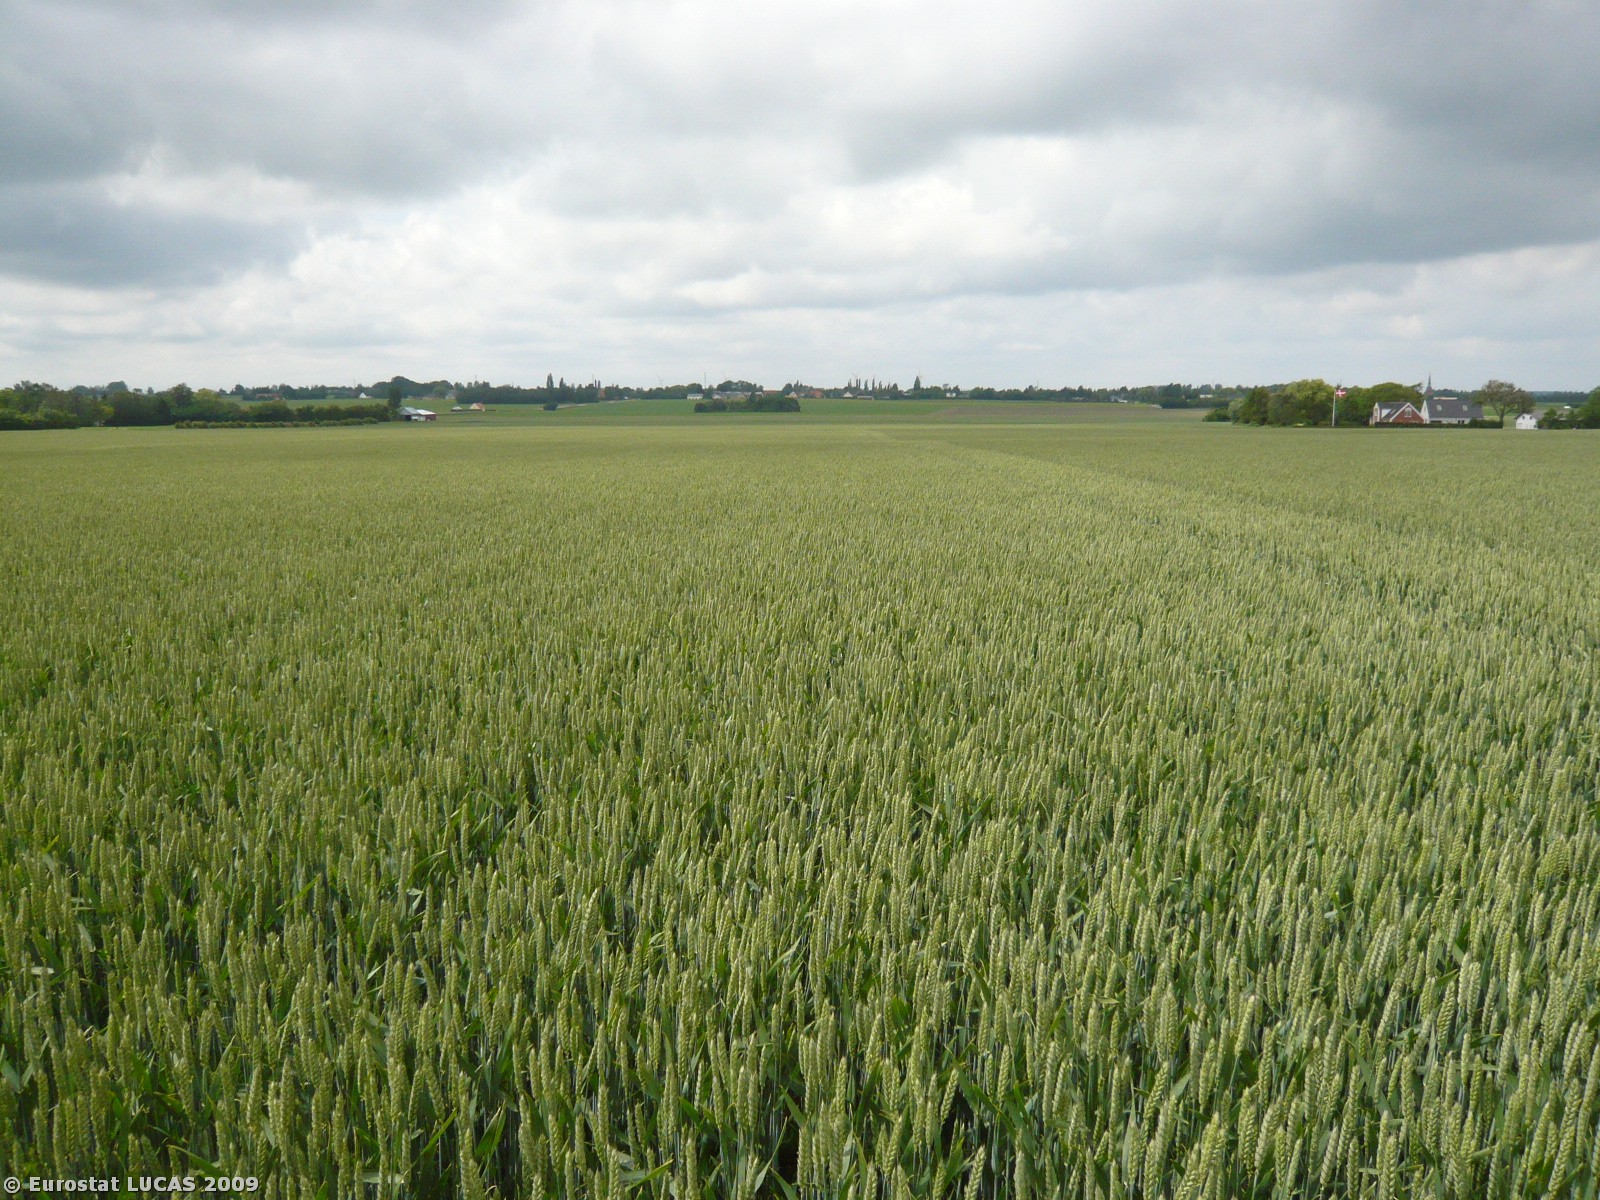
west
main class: Cropland
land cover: Common wheat
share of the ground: > 75 %
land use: Agriculture (excluding fallow land and kitchen gardens)
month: June
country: DK
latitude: 54.8983
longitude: 11.8232
